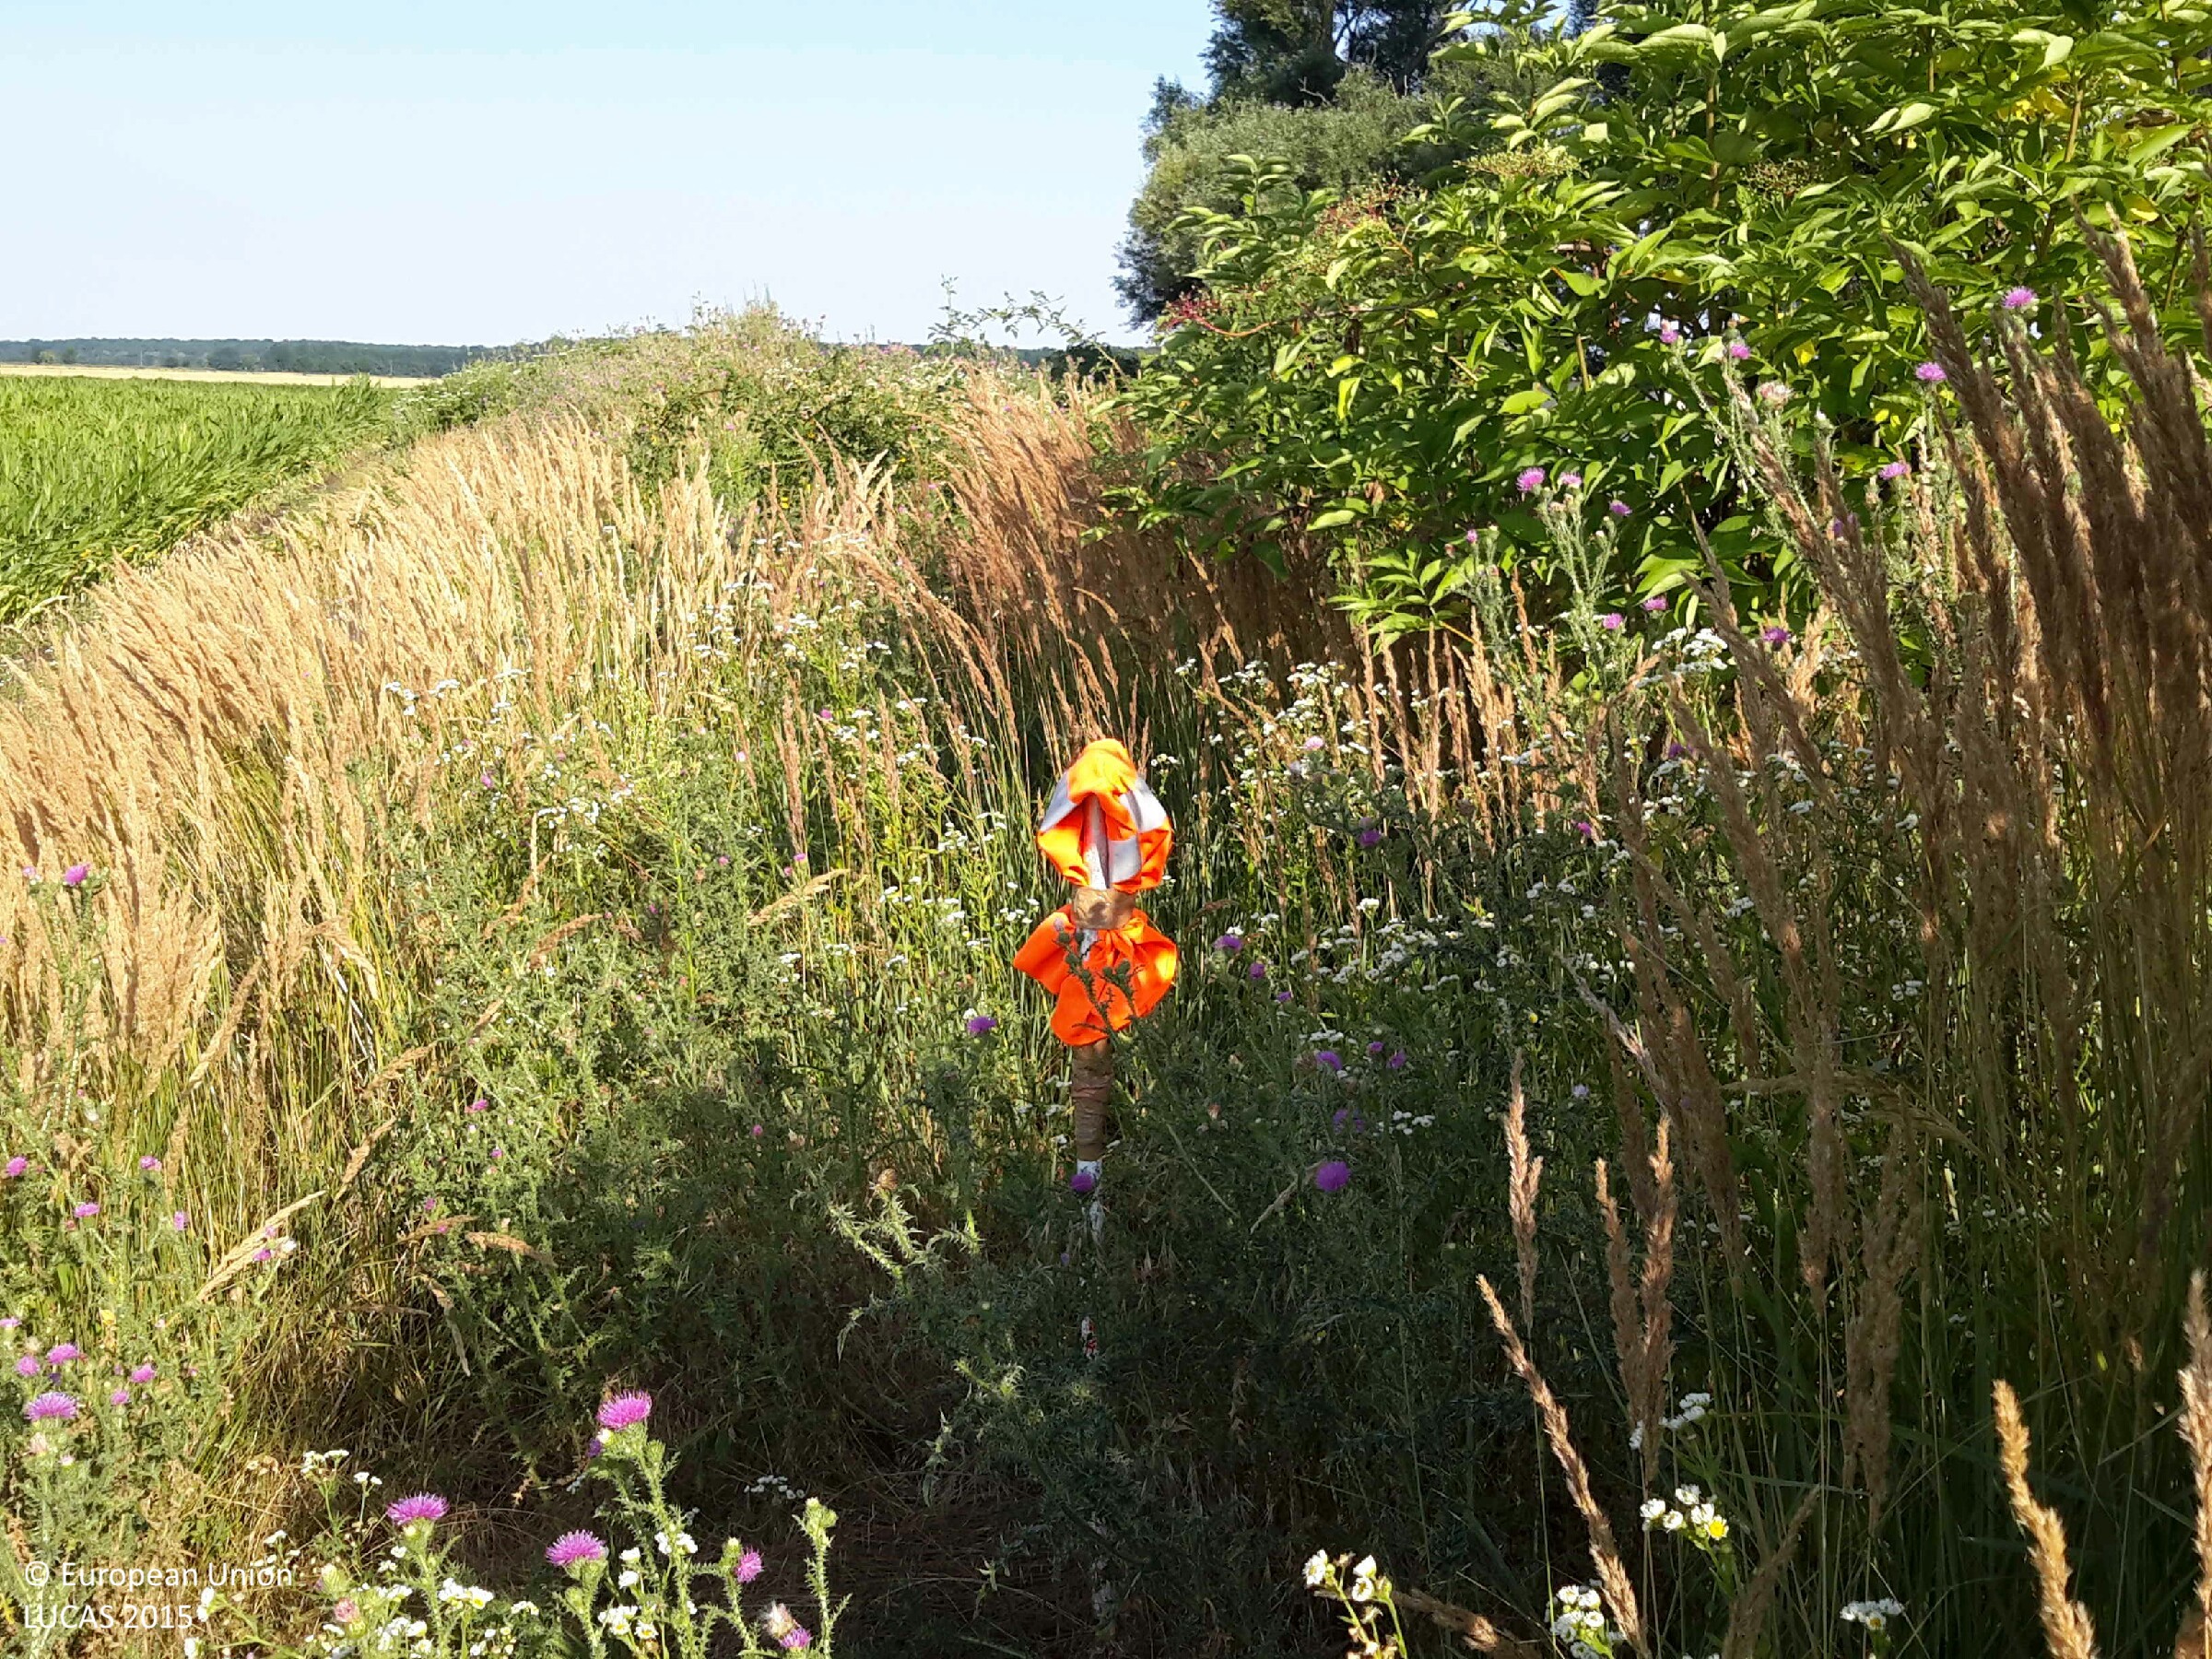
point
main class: Grassland
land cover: Grassland with sparse tree/shrub cover
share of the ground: > 75 %
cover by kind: herbaceous plants 90 %, broadleaved forest trees 5 %, shrubs 5 %
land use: Semi-natural and natural areas not in use
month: July
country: HU
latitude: 47.5437
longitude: 17.0878
